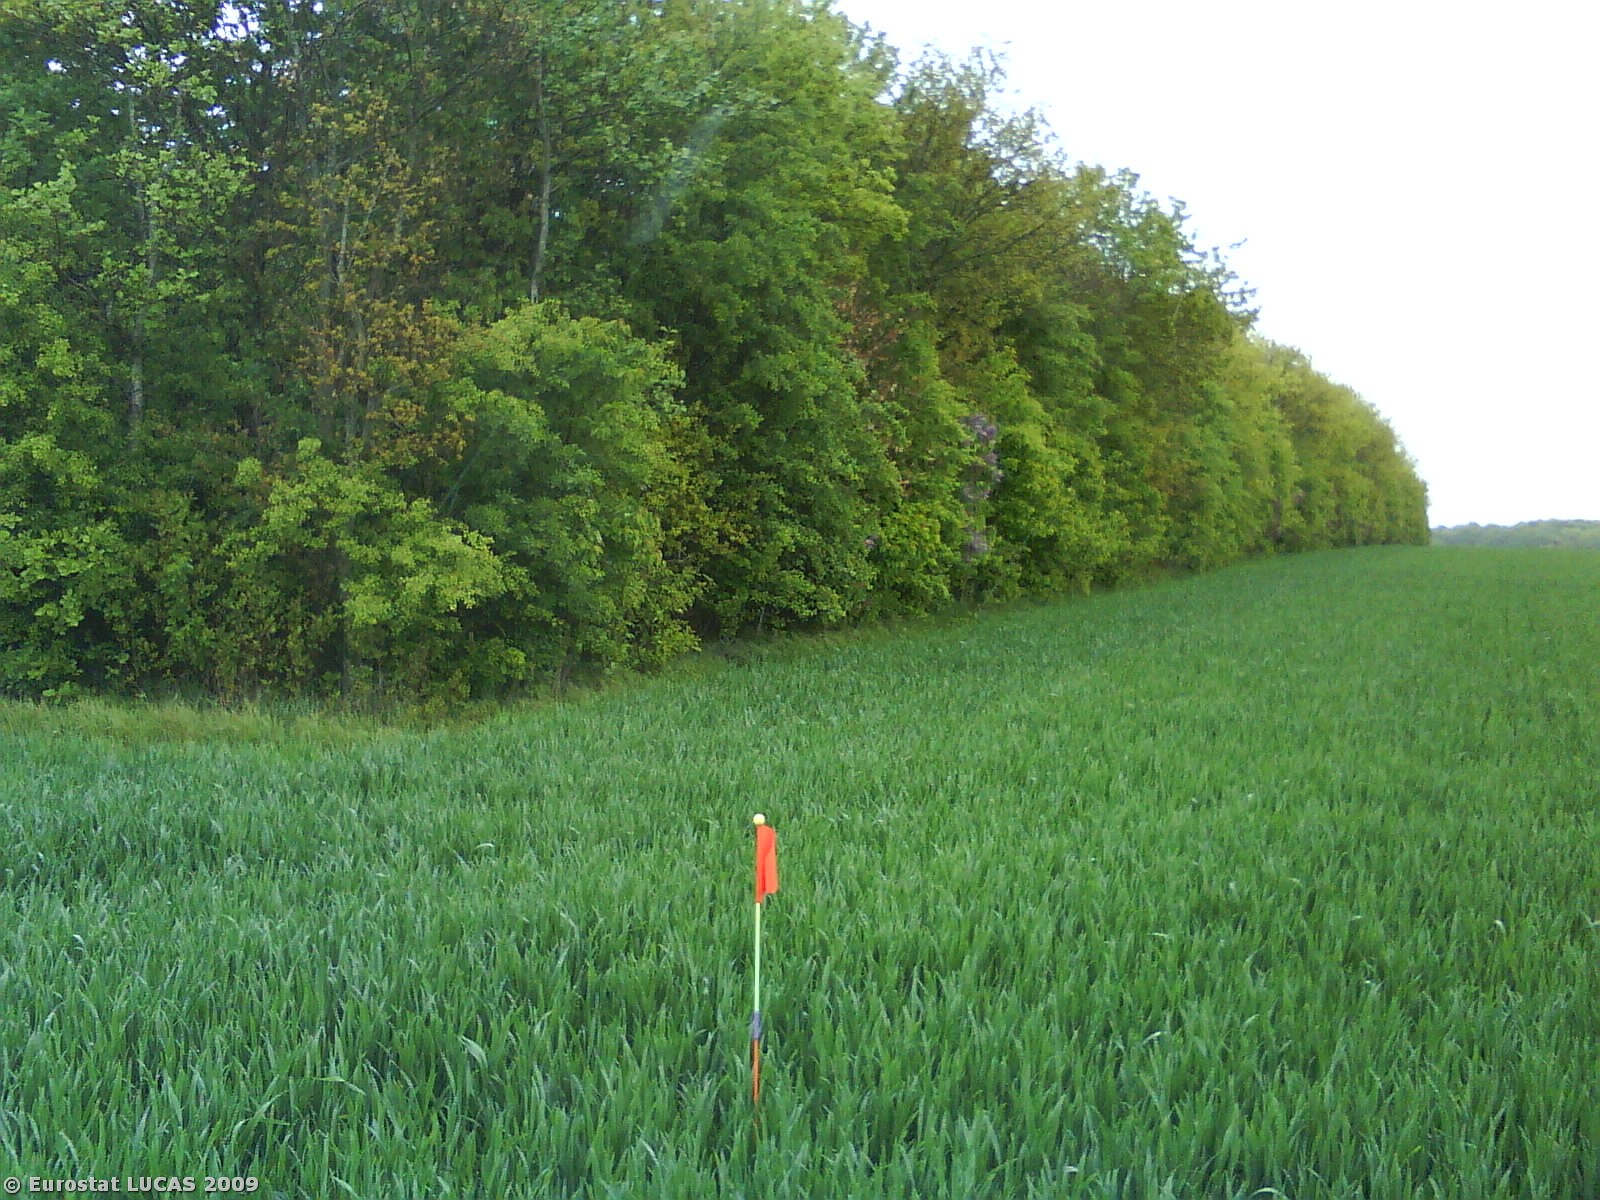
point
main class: Cropland
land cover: Common wheat
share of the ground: > 75 %
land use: Agriculture (excluding fallow land and kitchen gardens)
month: May
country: DK
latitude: 56.3315
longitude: 10.1454
